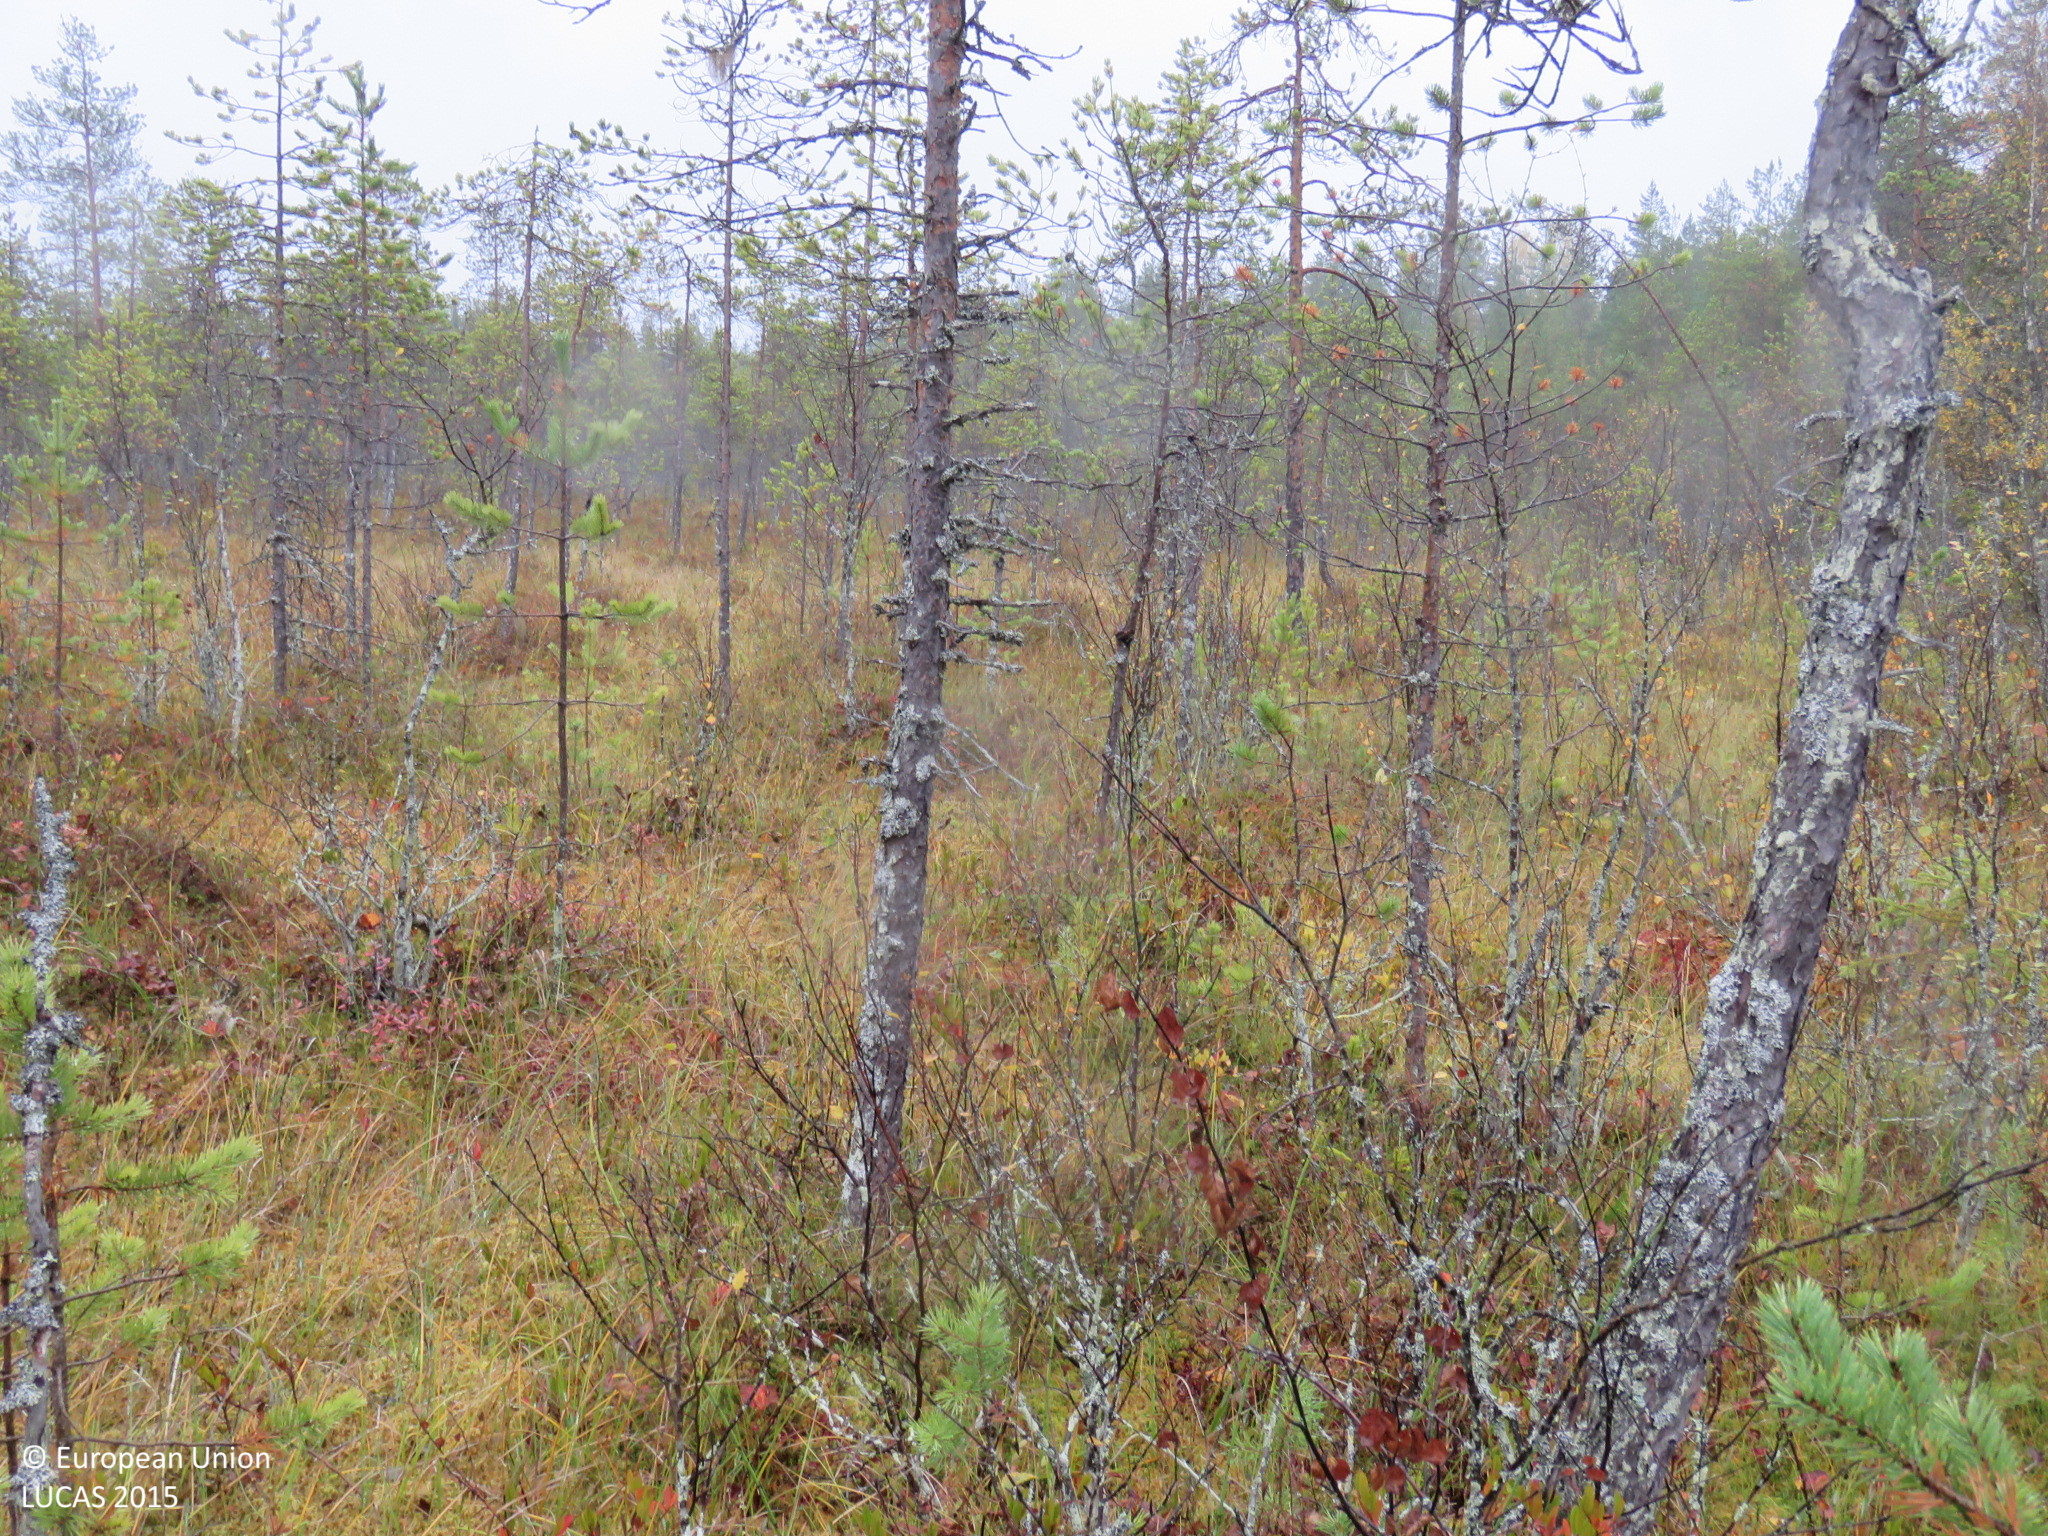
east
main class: Woodland
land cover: Pine dominated coniferous woodland
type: mire and swamp forests
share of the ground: 50 - 75 %
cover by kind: coniferous forest trees 70 %, shrubs 15 %, herbaceous plants 10 %, lichens and mosses 5 %
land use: Semi-natural and natural areas not in use
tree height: < 5 m
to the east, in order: Pine dominated coniferous woodland; Pine dominated mixed woodland; Ditches and canals; Broadleaved woodland; Ditches and canals; Broadleaved woodland; Ditches and canals; Broadleaved woodland; Ditches and canals; Broadleaved woodland; Ditches and canals; Broadleaved woodland
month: September
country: FI
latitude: 64.8653
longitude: 26.6351
